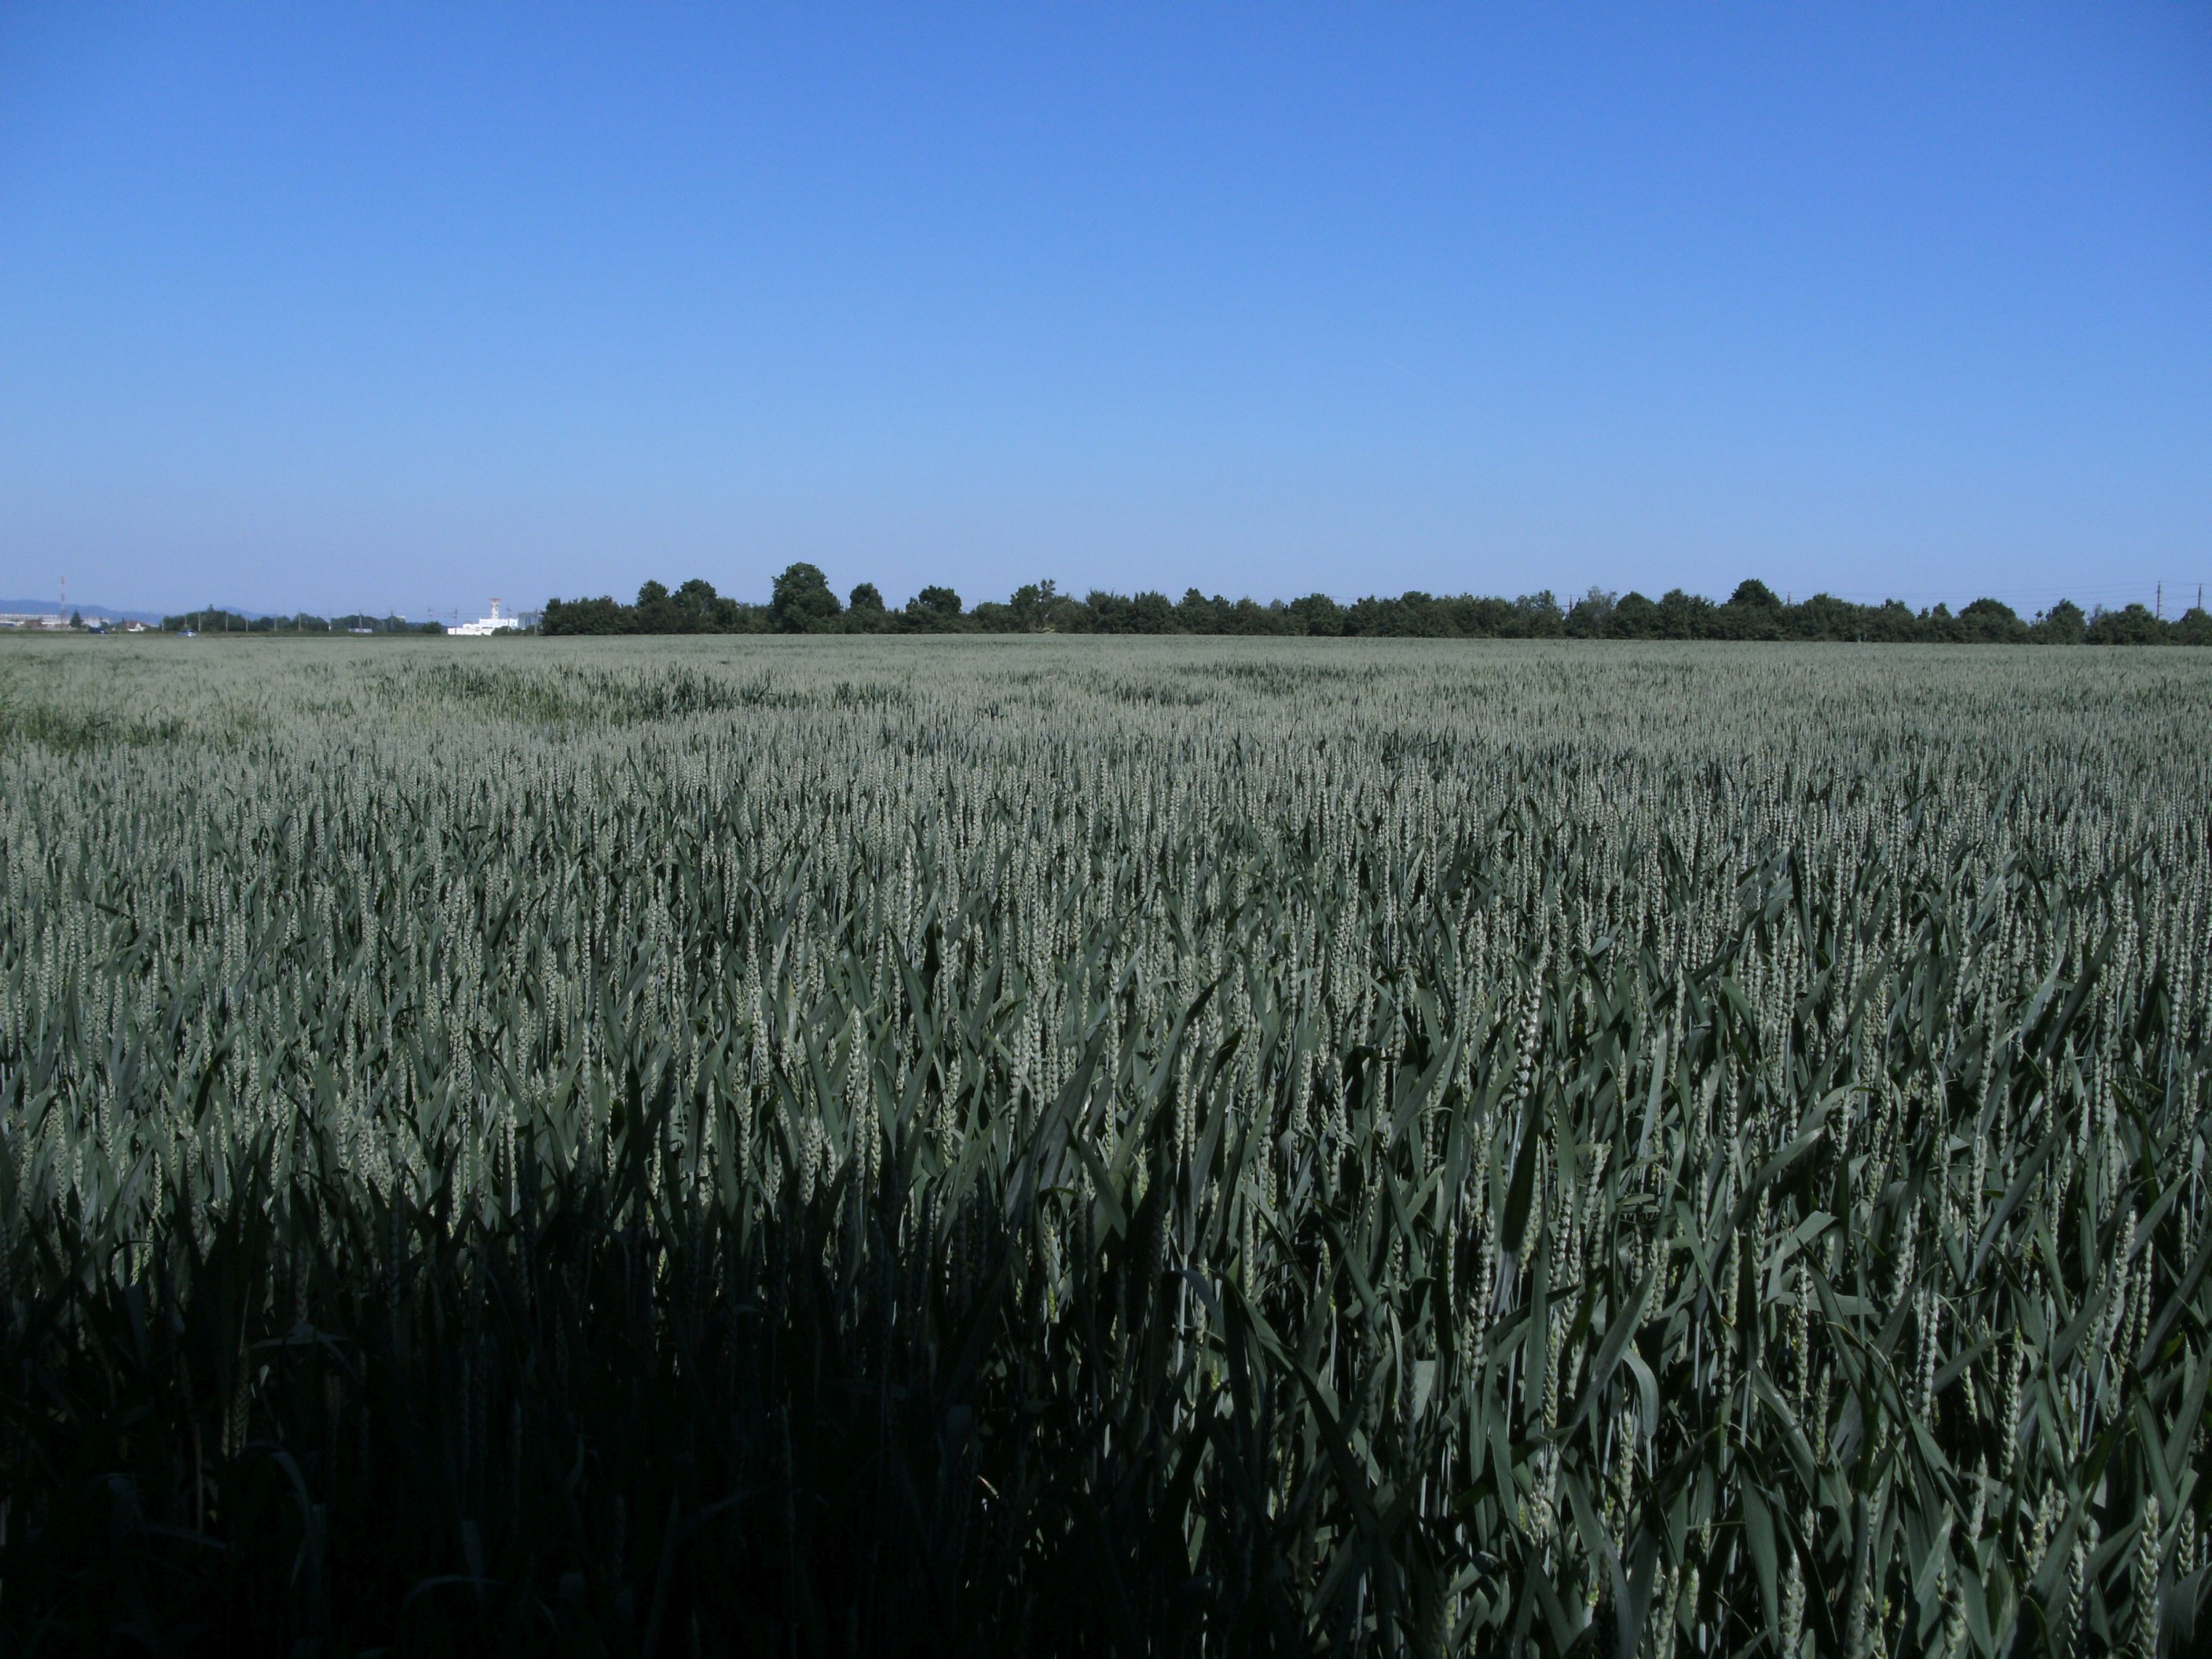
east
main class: Cropland
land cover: Common wheat
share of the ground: > 75 %
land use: Agriculture (excluding fallow land and kitchen gardens)
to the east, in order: Common wheat
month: June
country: AT
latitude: 48.2352
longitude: 14.1602
